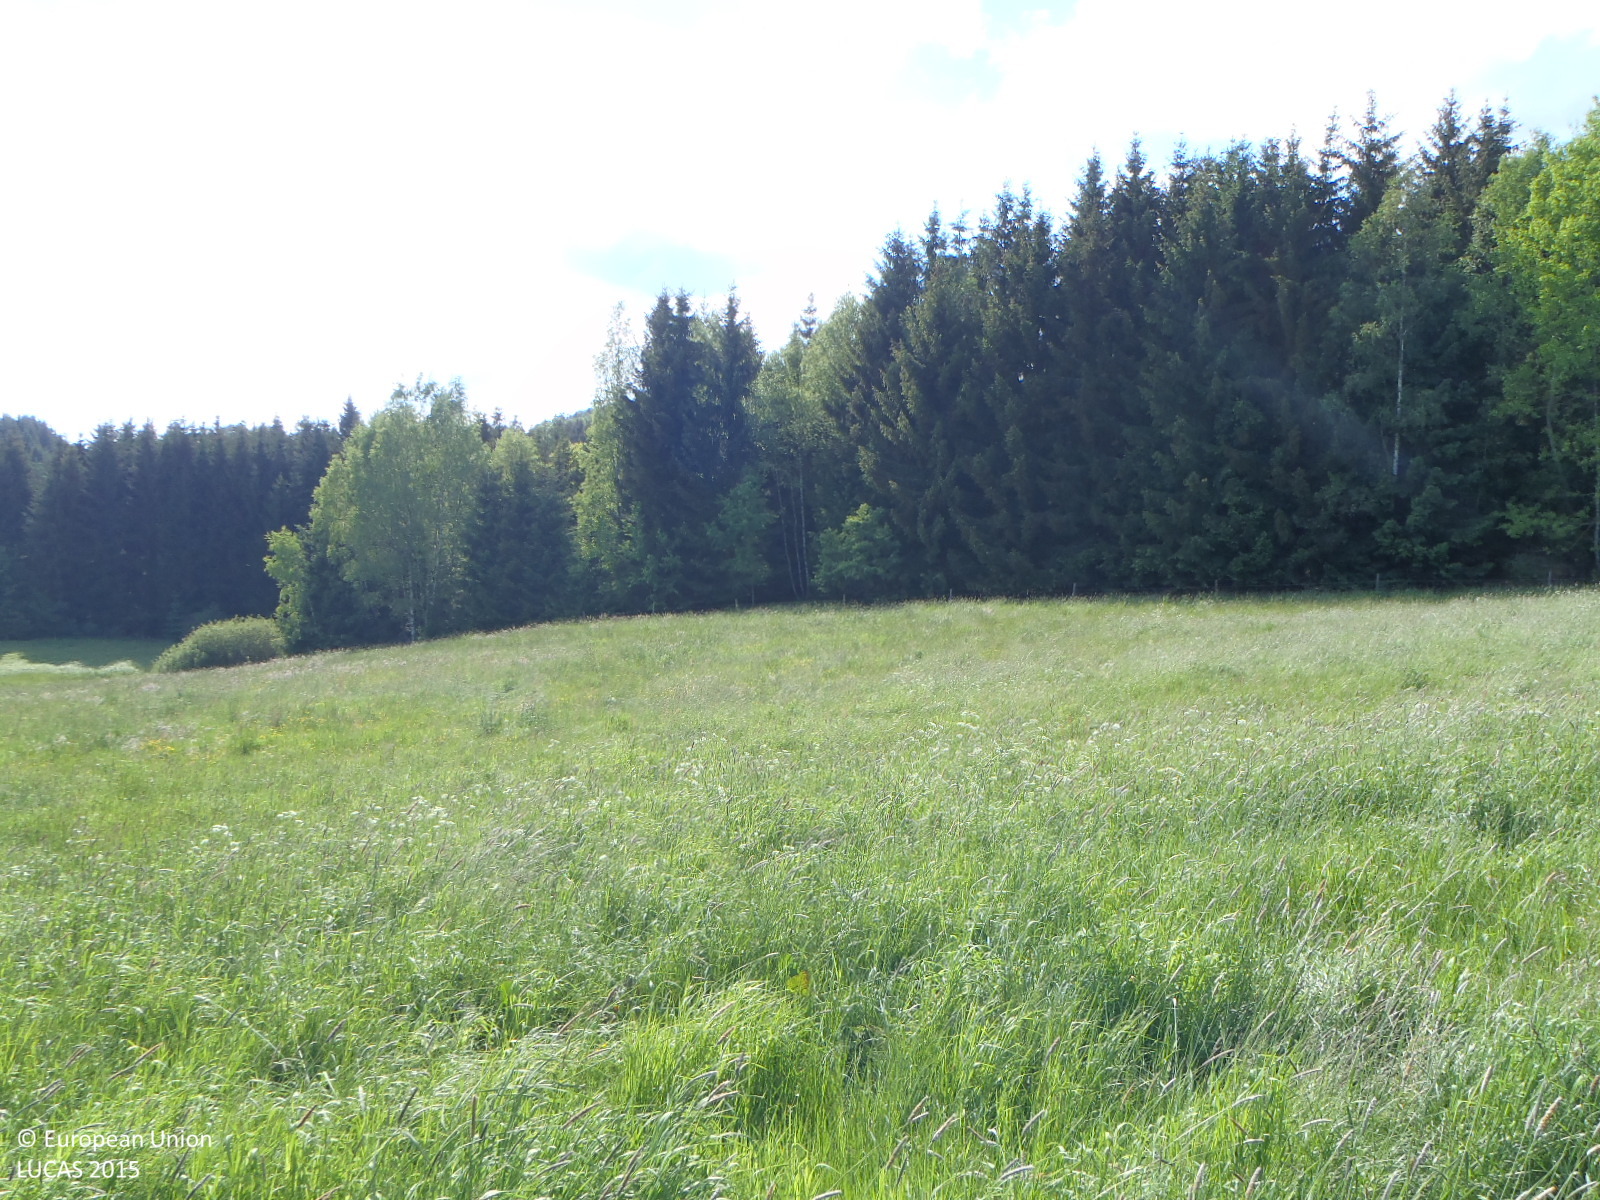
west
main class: Grassland
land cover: Grassland without tree/shrub cover
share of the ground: > 75 %
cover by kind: herbaceous plants 100 %
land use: Agriculture (excluding fallow land and kitchen gardens)
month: June
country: CZ
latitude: 48.6219
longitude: 14.4097
